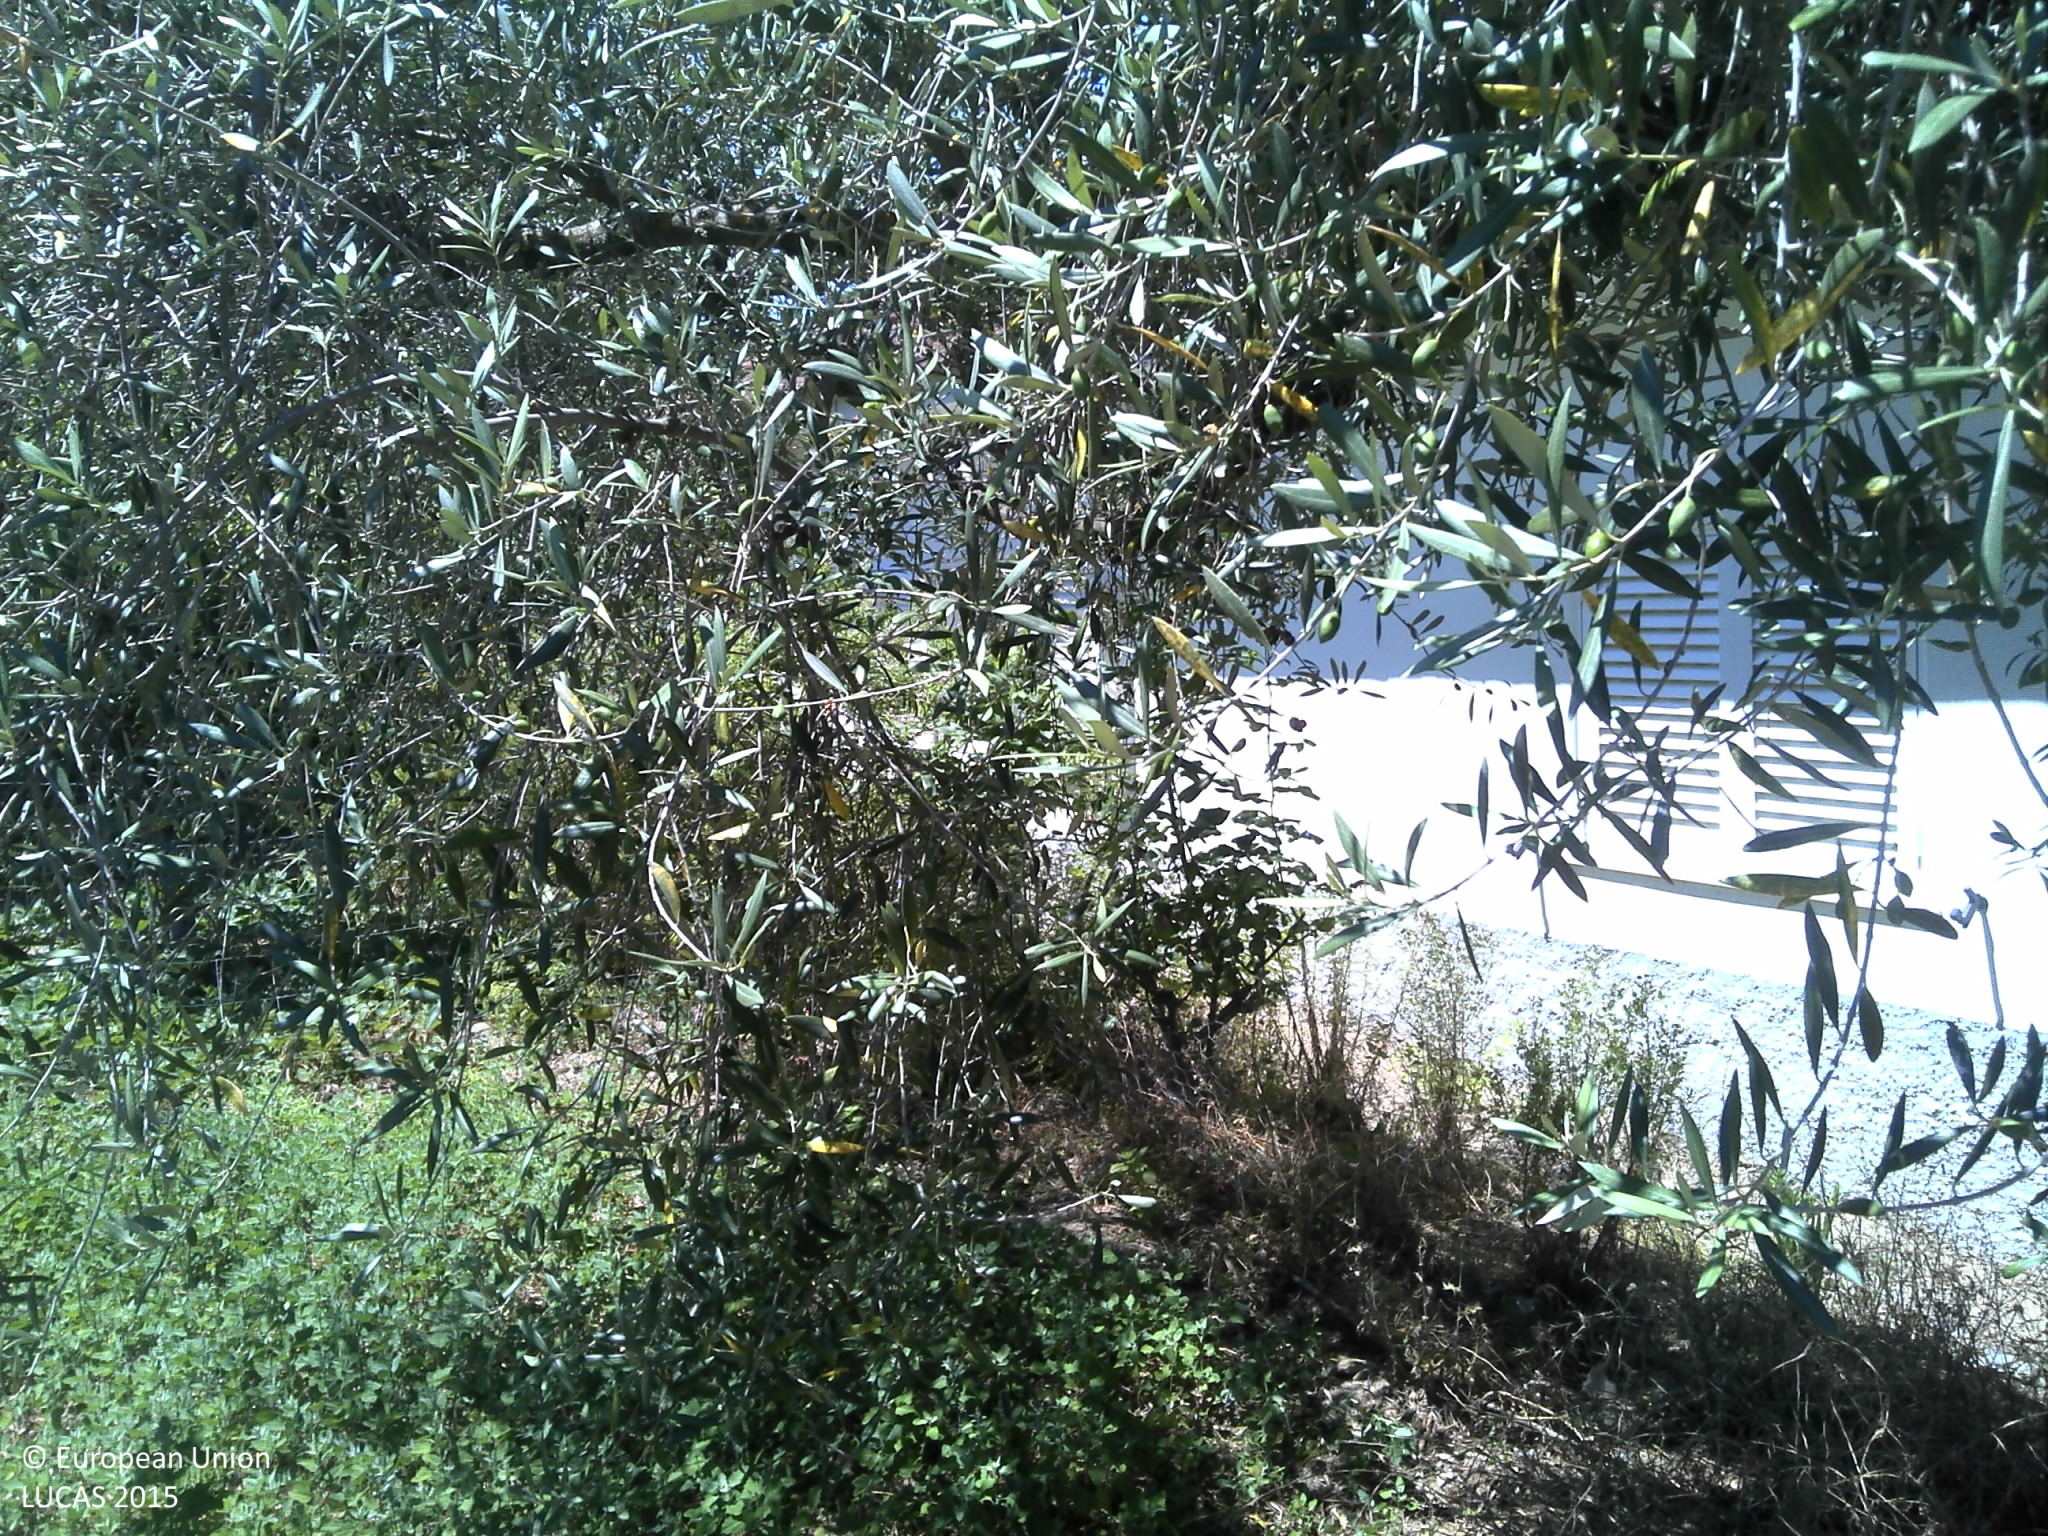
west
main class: Cropland
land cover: Other fruit trees and berries
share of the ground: 25 - 50 %
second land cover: Vineyards
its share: 25 - 50 %
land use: Agriculture (excluding fallow land and kitchen gardens)
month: June
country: PT
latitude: 40.0686
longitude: -7.2752
